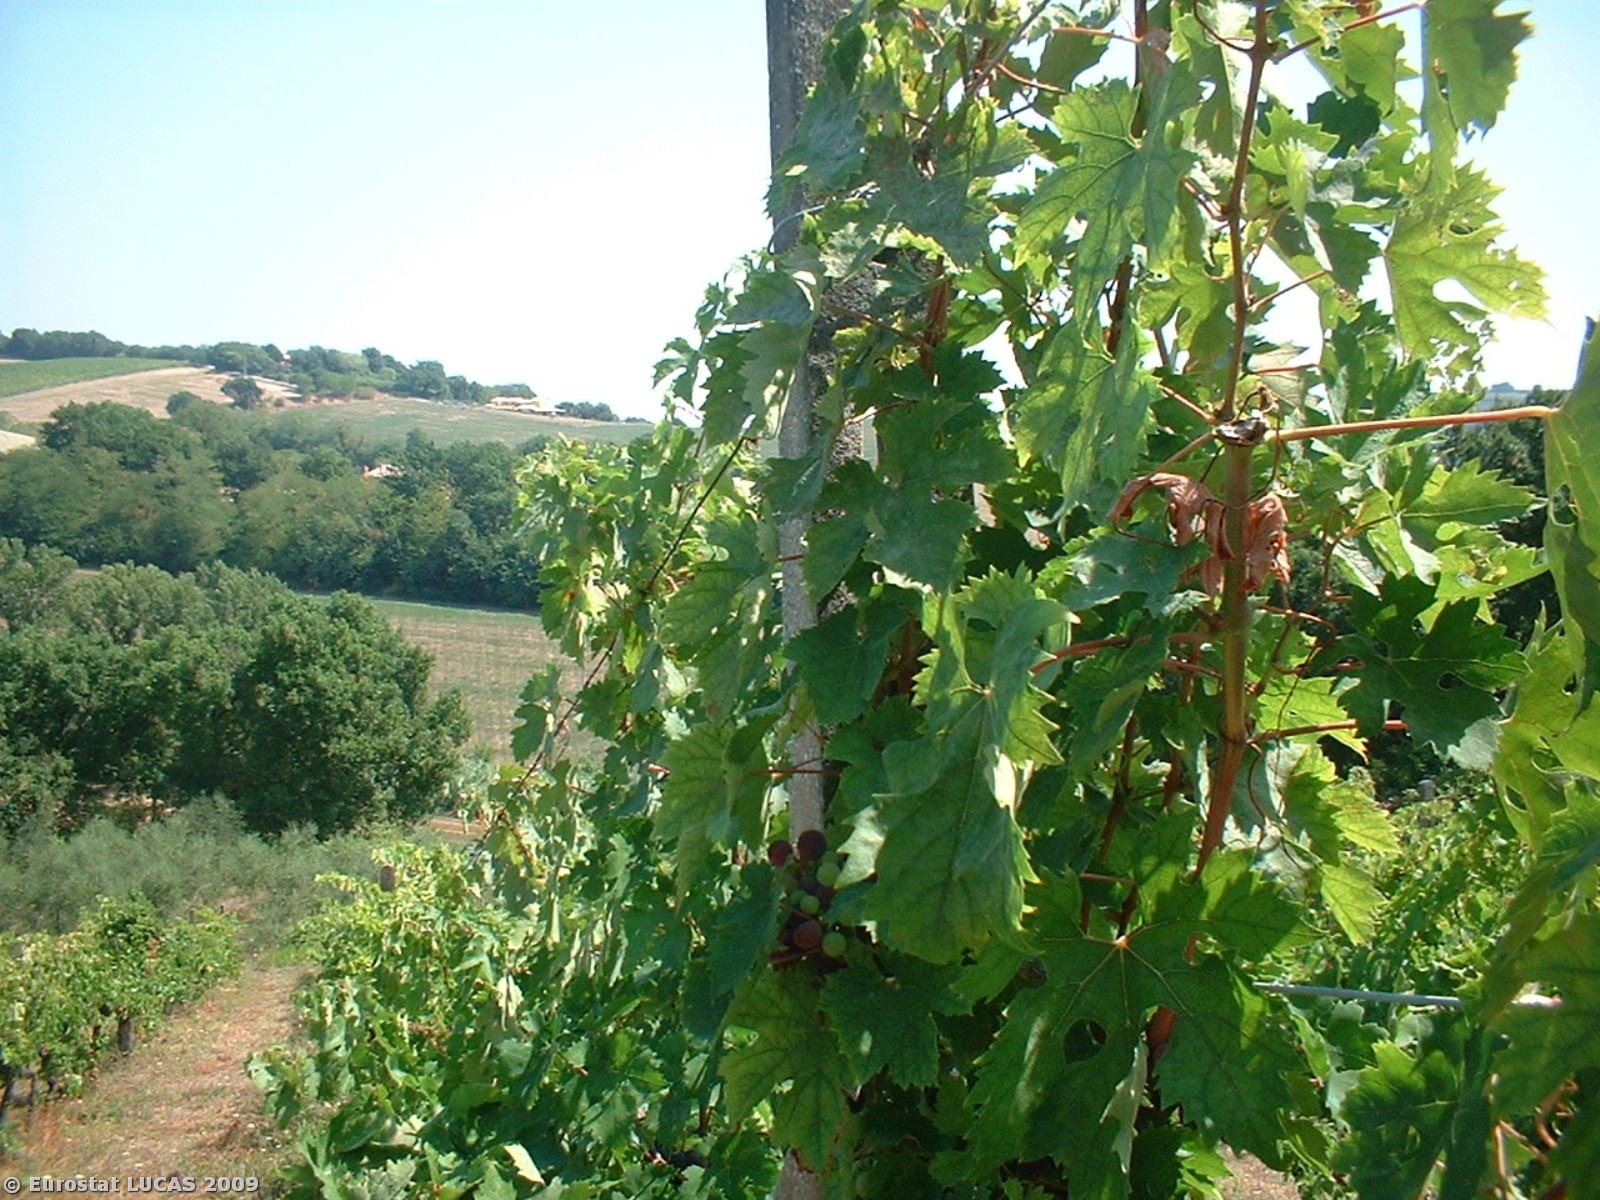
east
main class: Cropland
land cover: Vineyards
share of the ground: 25 - 50 %
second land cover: Grassland with sparse tree/shrub cover
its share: > 75 %
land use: Agriculture (excluding fallow land and kitchen gardens)
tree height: < 5 m
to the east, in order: Vineyards; Grassland with sparse tree/shrub cover; Abandoned hedges; Olive groves; Grassland with sparse tree/shrub cover; Broadleaved woodland; Durum wheat; Abandoned hedges; Ditches and canals; Abandoned hedges; Electric lines; Lucerne; Broadleaved woodland; Paved roads, cycling and walking lanes; Abandoned hedges
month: July
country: IT
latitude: 43.8396
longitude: 12.9408
